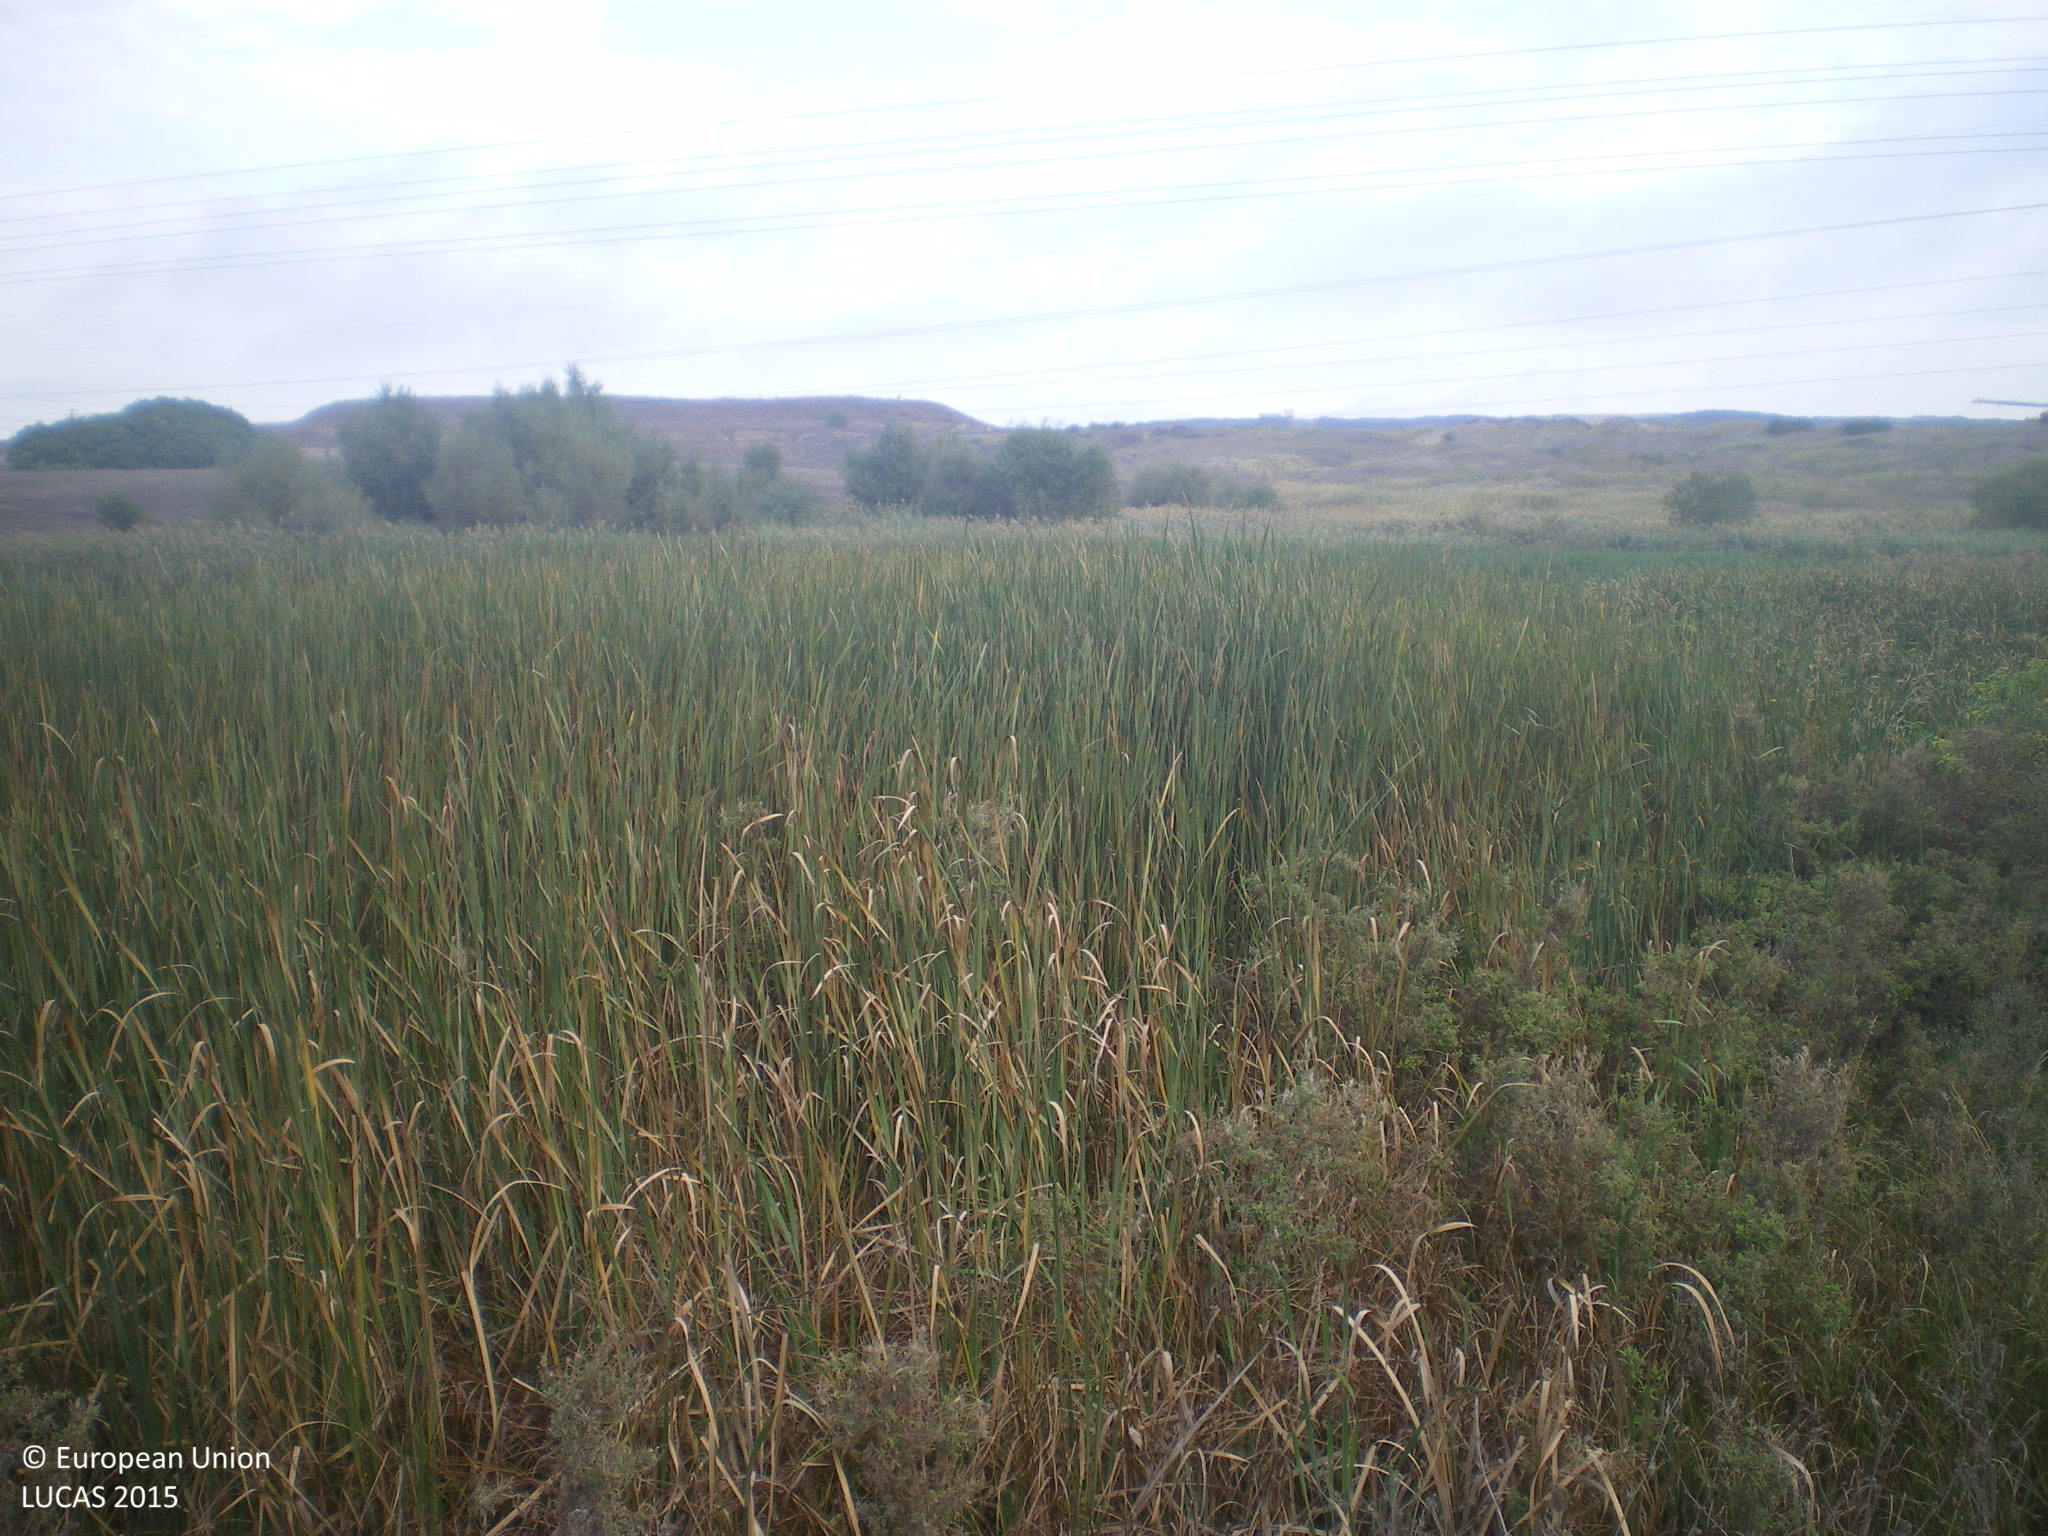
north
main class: Grassland
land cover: Grassland with sparse tree/shrub cover
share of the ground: > 75 %
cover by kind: herbaceous plants 90 %, broadleaved forest trees 5 %, shrubs 5 %
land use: Mining and quarrying
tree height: > 5 m
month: October
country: BG
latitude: 42.2518
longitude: 26.0168
